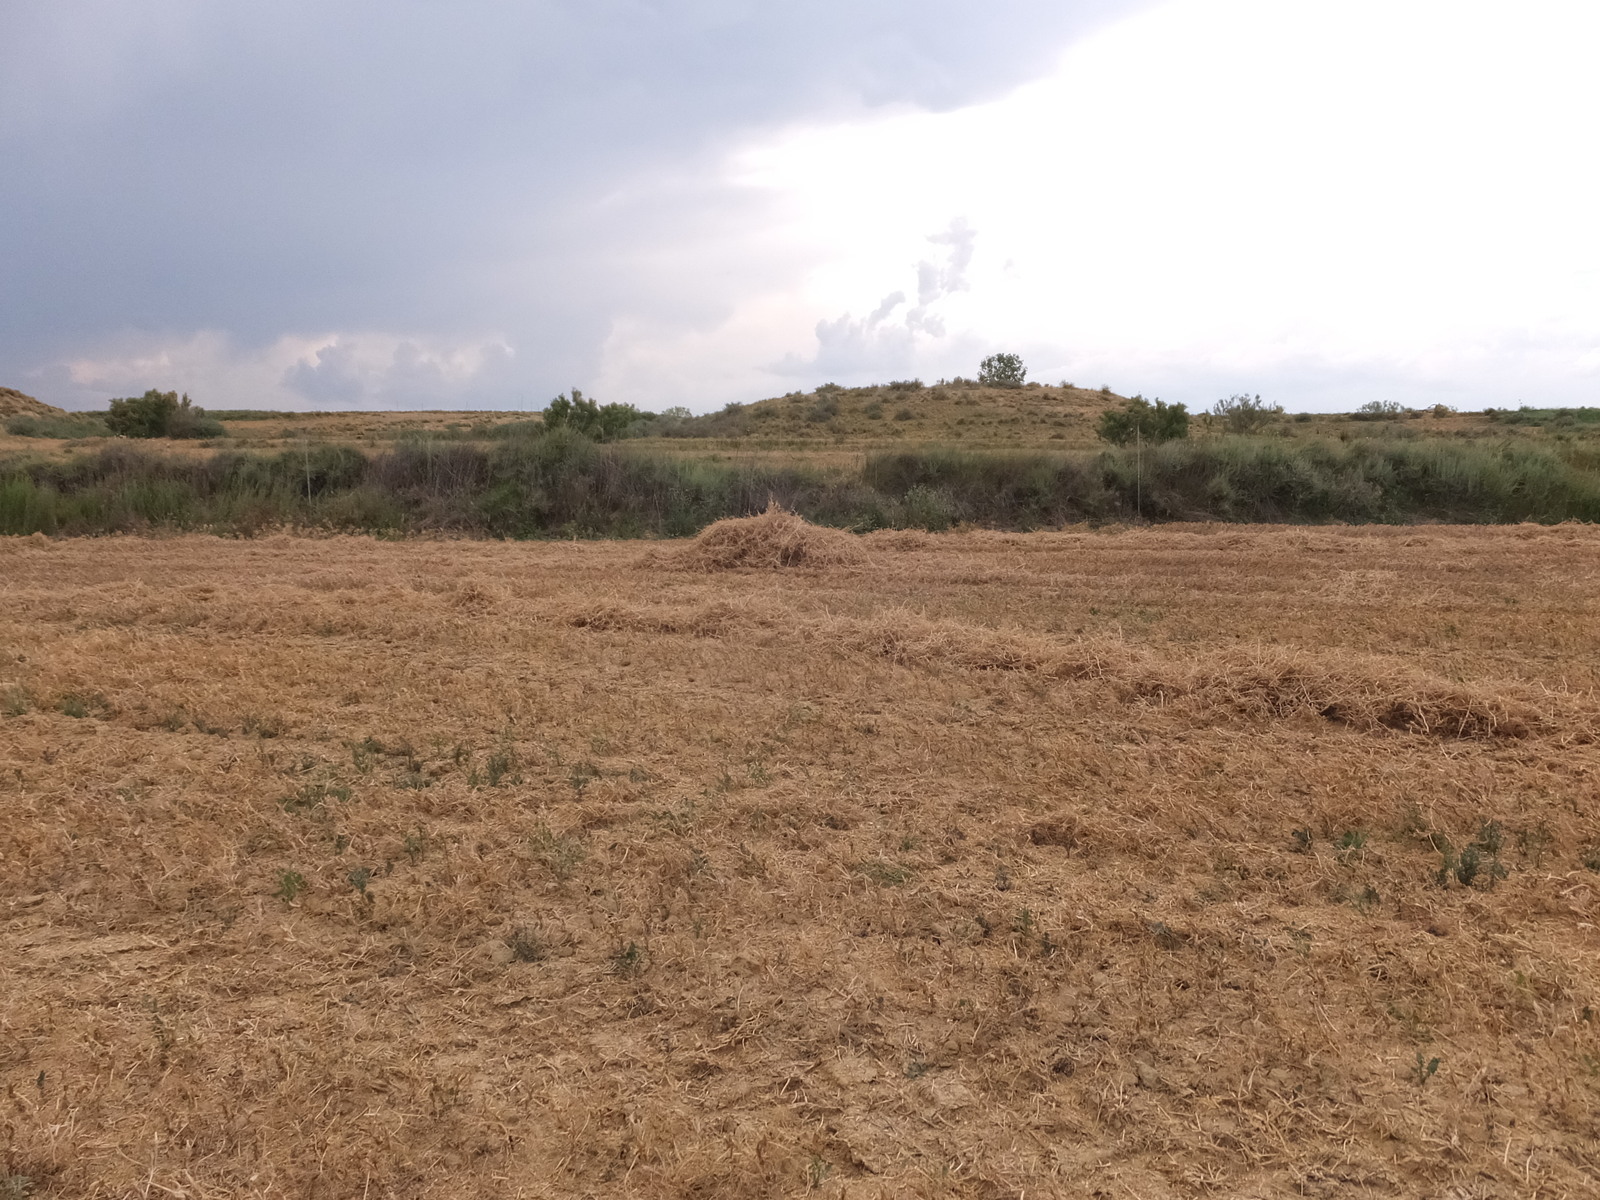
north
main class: Cropland
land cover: Dry pulses
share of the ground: < 10 %
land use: Agriculture (excluding fallow land and kitchen gardens)
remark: Harvested field
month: June
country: ES
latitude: 41.8199
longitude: 0.0752
